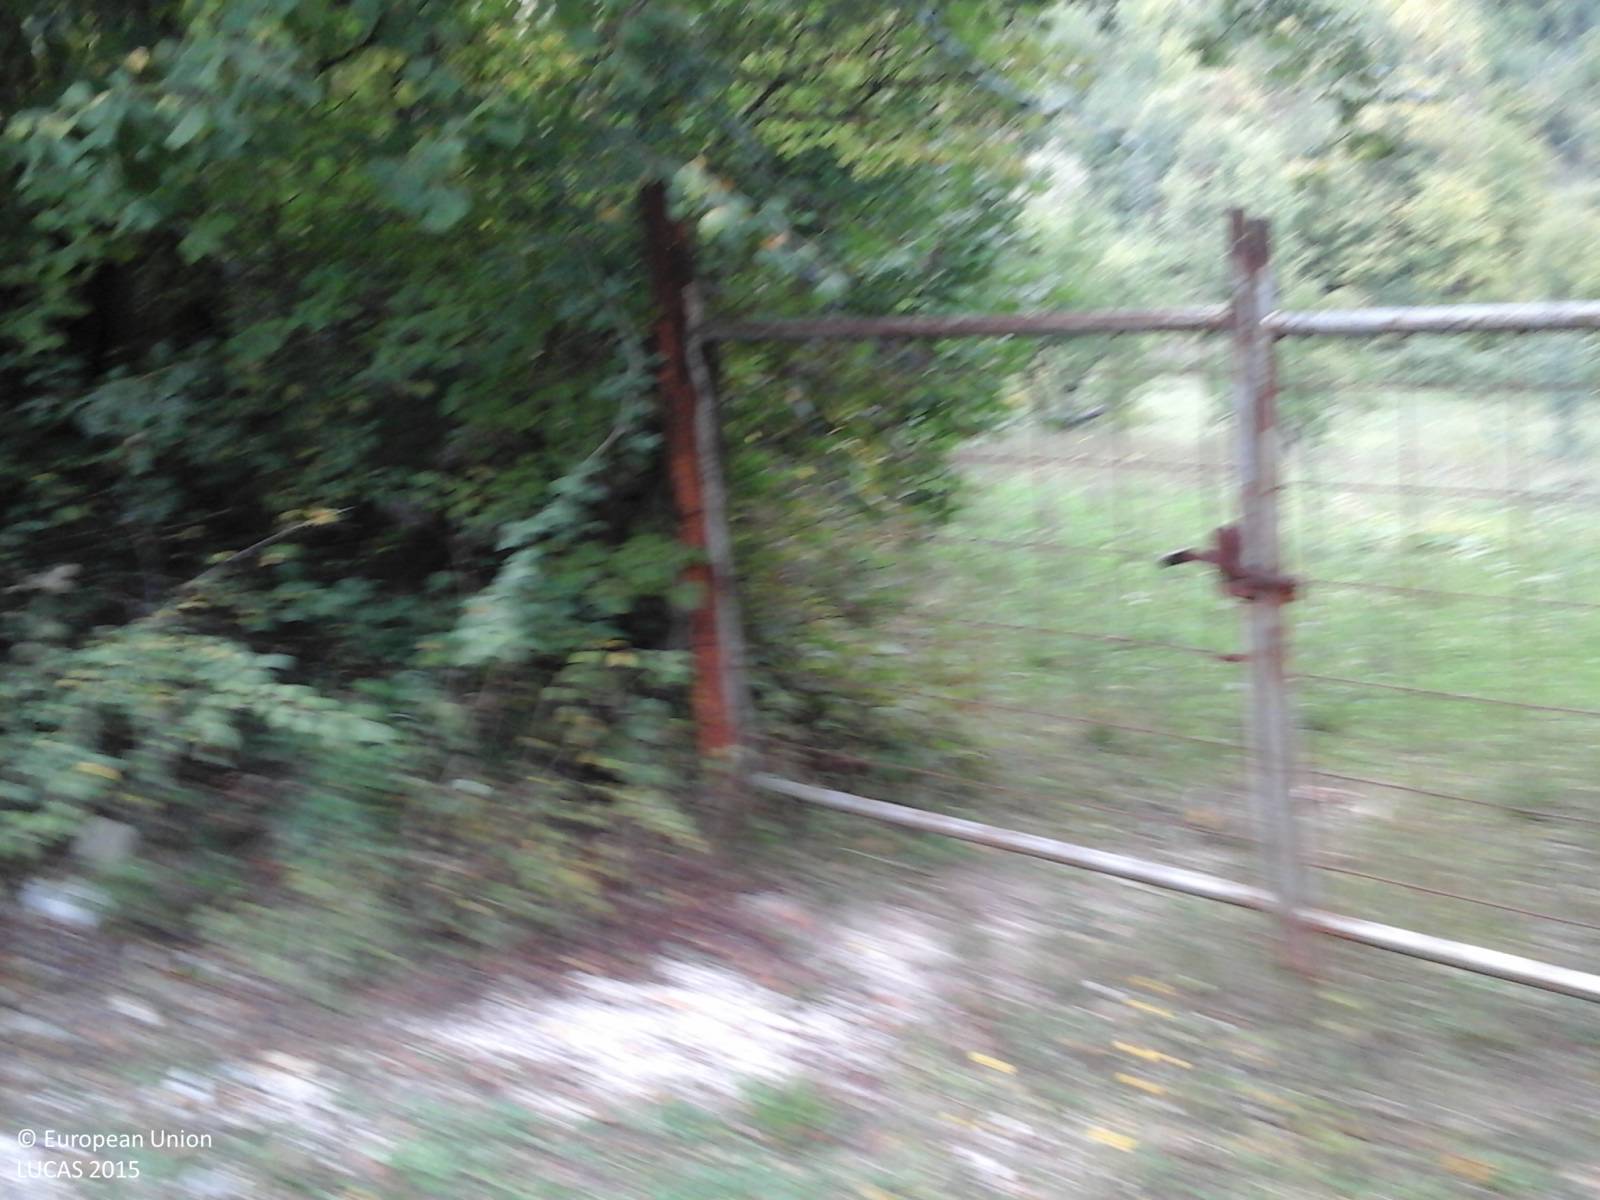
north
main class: Grassland
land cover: Grassland without tree/shrub cover
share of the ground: > 75 %
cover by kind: herbaceous plants 100 %
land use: Agriculture (excluding fallow land and kitchen gardens)
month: October
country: IT
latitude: 42.2608
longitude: 13.1776
